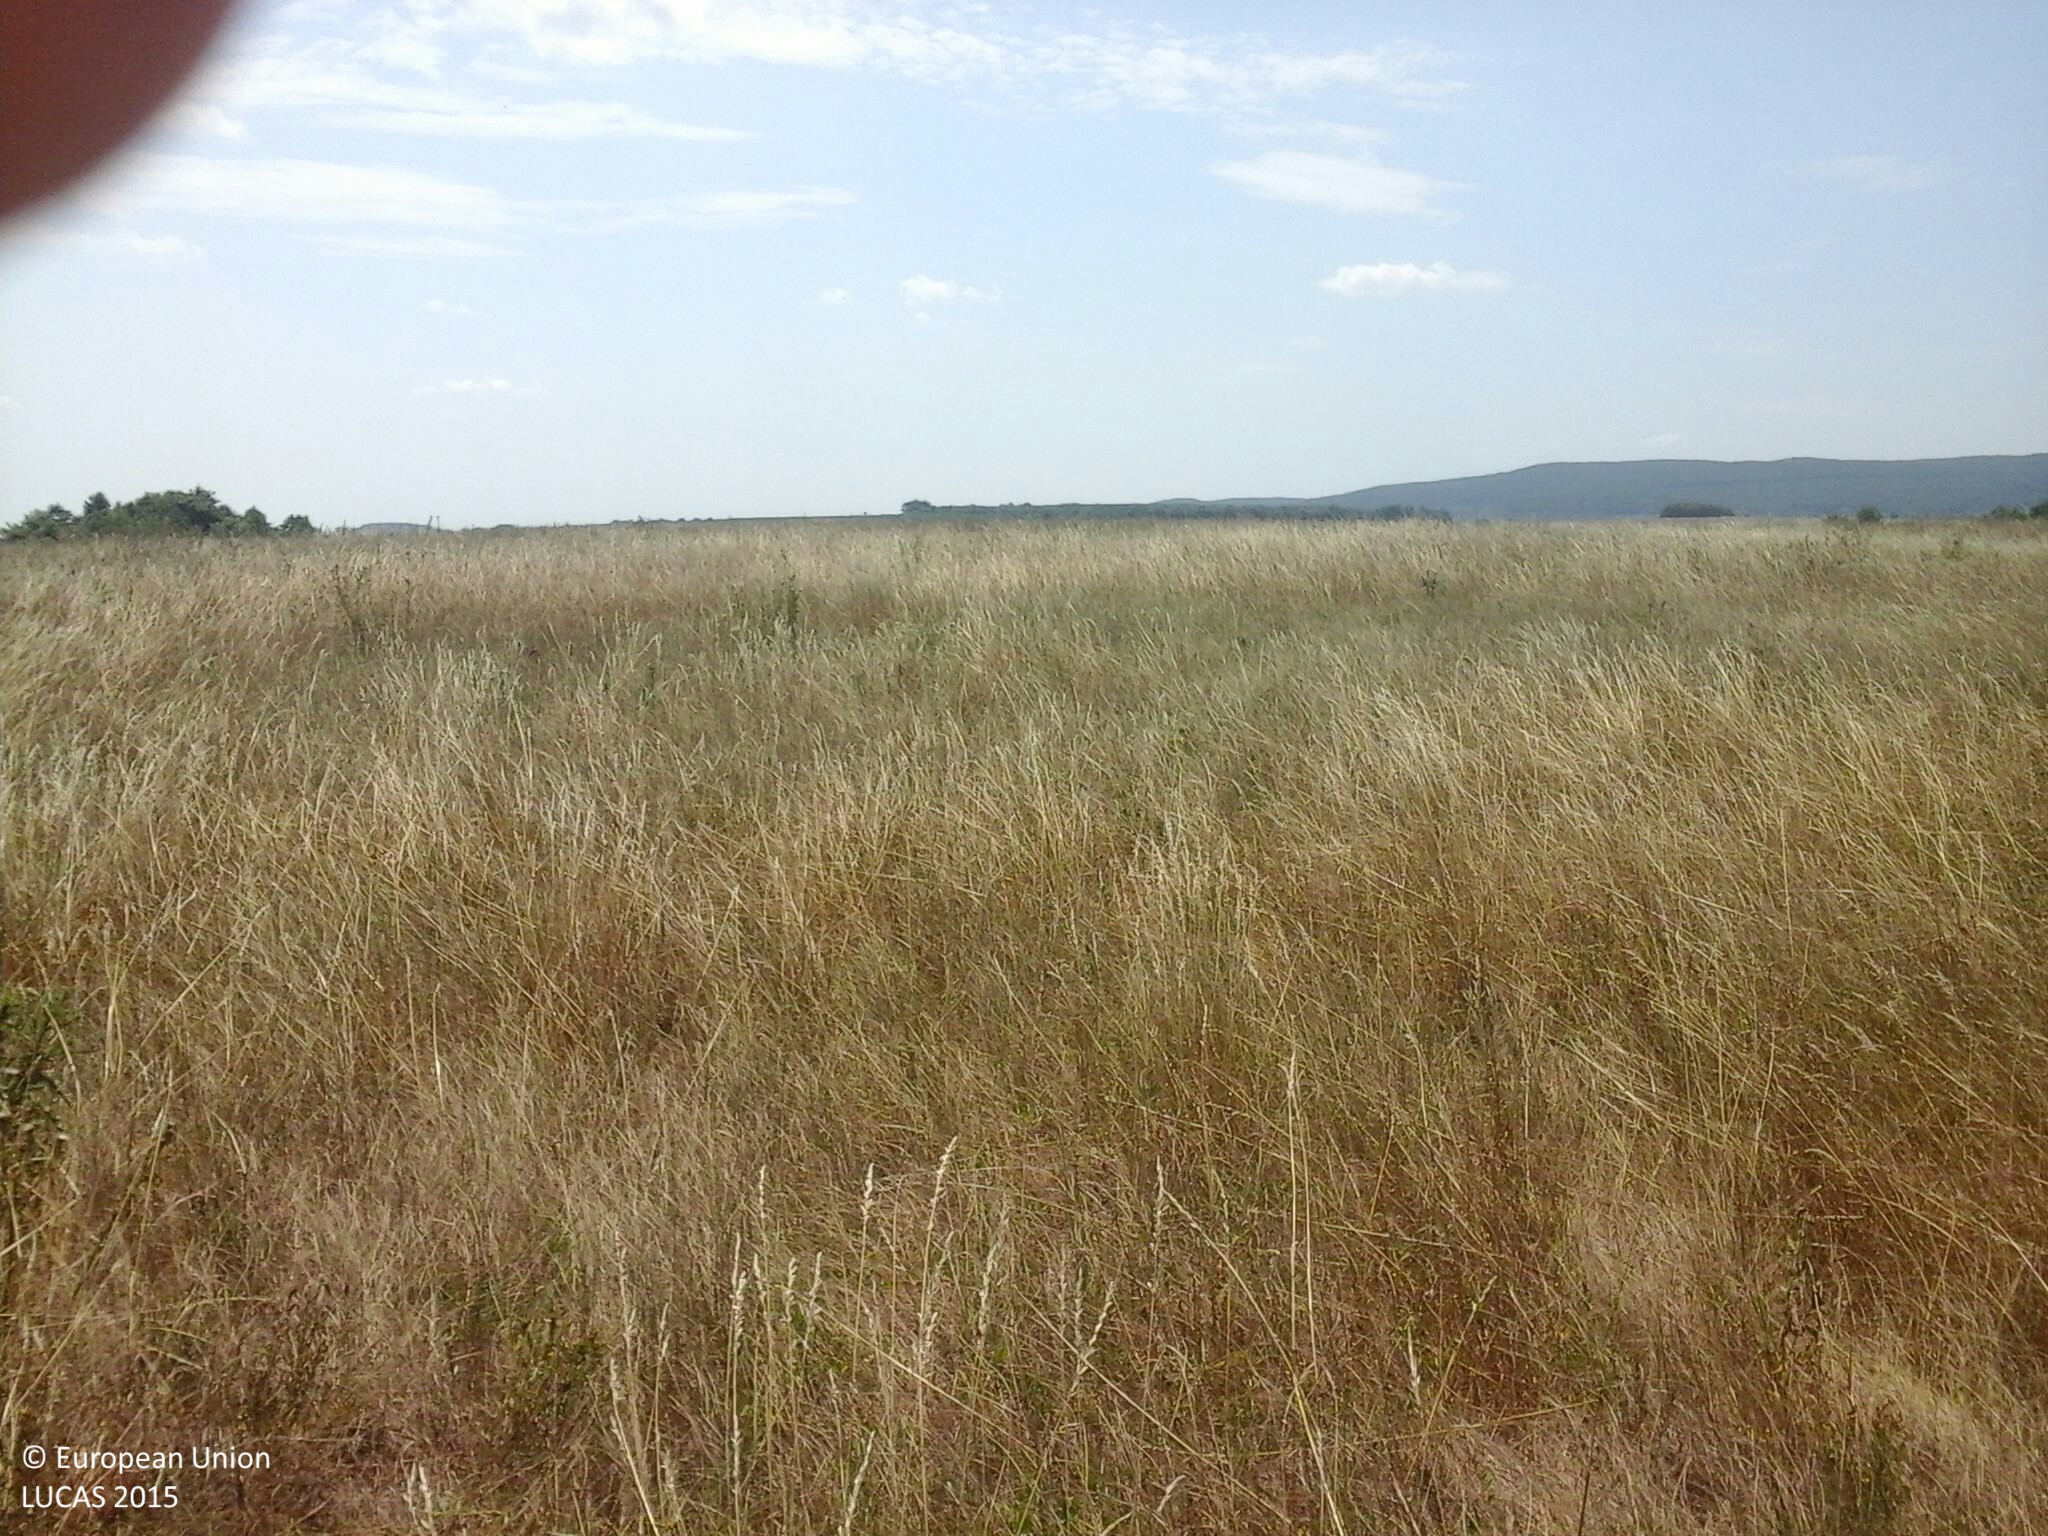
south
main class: Grassland
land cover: Grassland without tree/shrub cover
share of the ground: > 75 %
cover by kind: herbaceous plants 100 %
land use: Agriculture (excluding fallow land and kitchen gardens)
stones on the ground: < 10 %
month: July
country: HU
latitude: 47.0392
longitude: 17.3364
